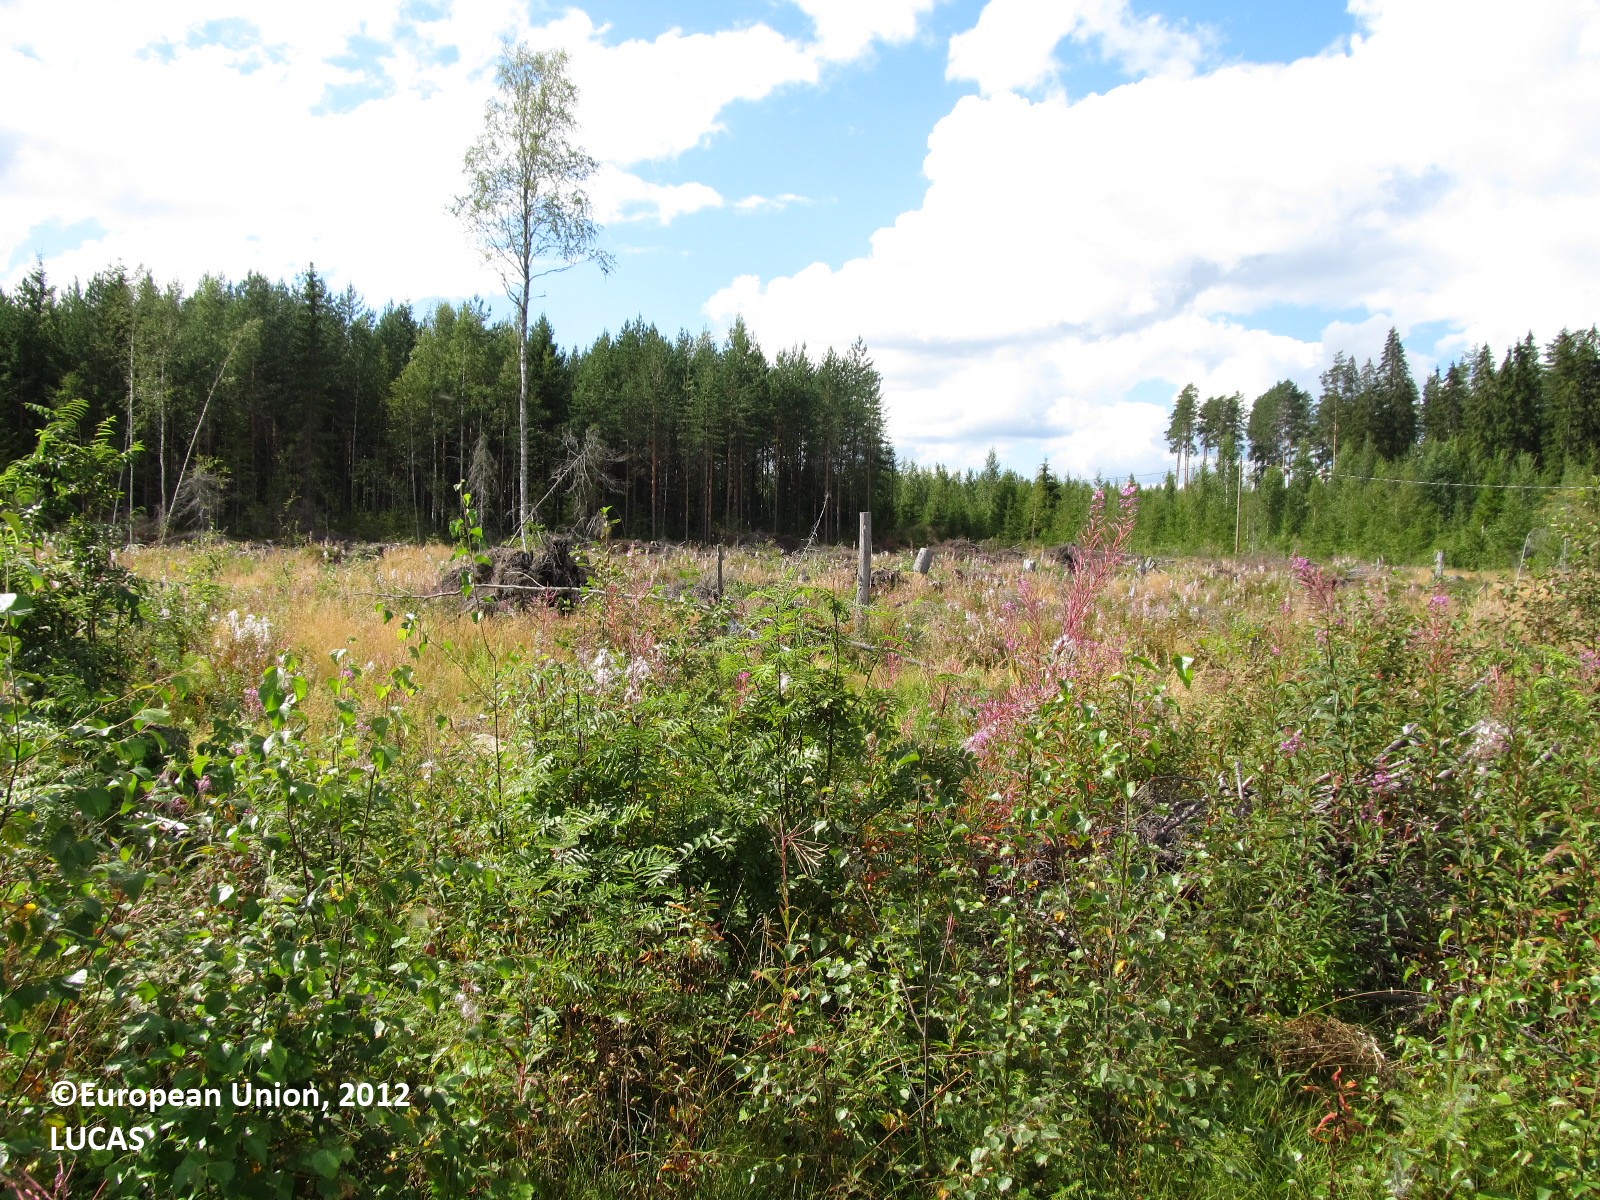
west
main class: Shrubland
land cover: Shrubland with sparse tree cover
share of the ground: 25 - 50 %
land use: Forestry
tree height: < 5 m
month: August
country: FI
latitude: 62.2104
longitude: 27.6124
